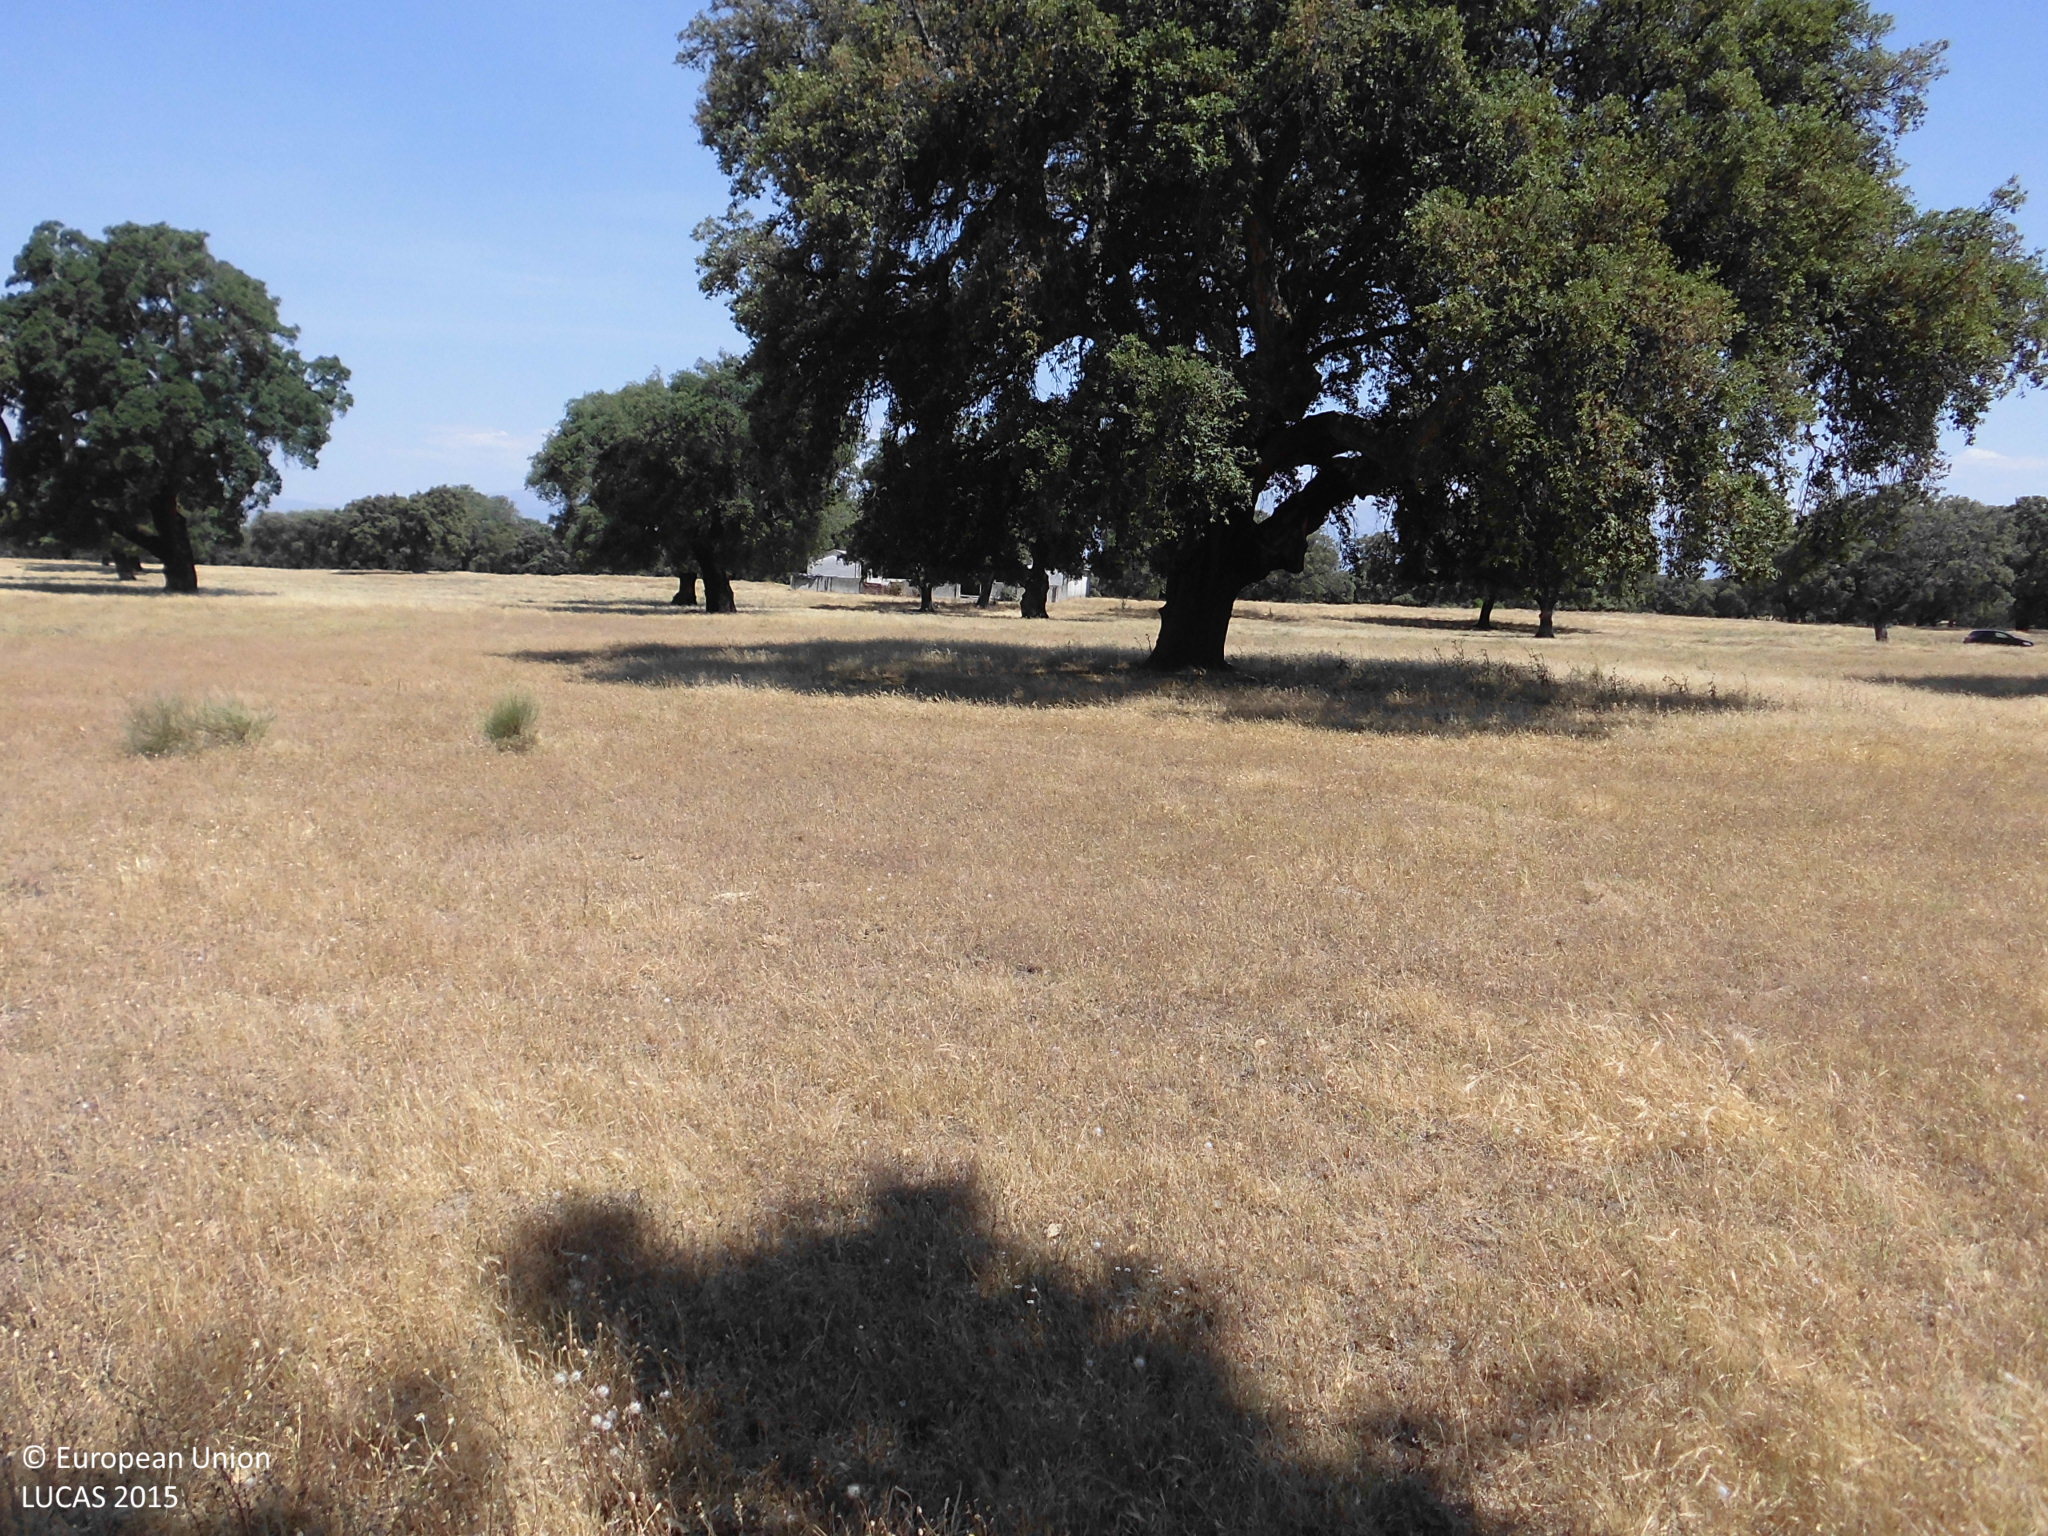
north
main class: Woodland
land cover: Broadleaved woodland
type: broadleaved evergreen forest
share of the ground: 25 - 50 %
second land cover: Grassland without tree/shrub cover
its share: > 75 %
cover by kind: herbaceous plants 75 %, broadleaved forest trees 25 %
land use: Forestry
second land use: Agriculture (excluding fallow land and kitchen gardens)
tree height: > 5 m
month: June
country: ES
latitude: 39.9364
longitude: -5.4465
